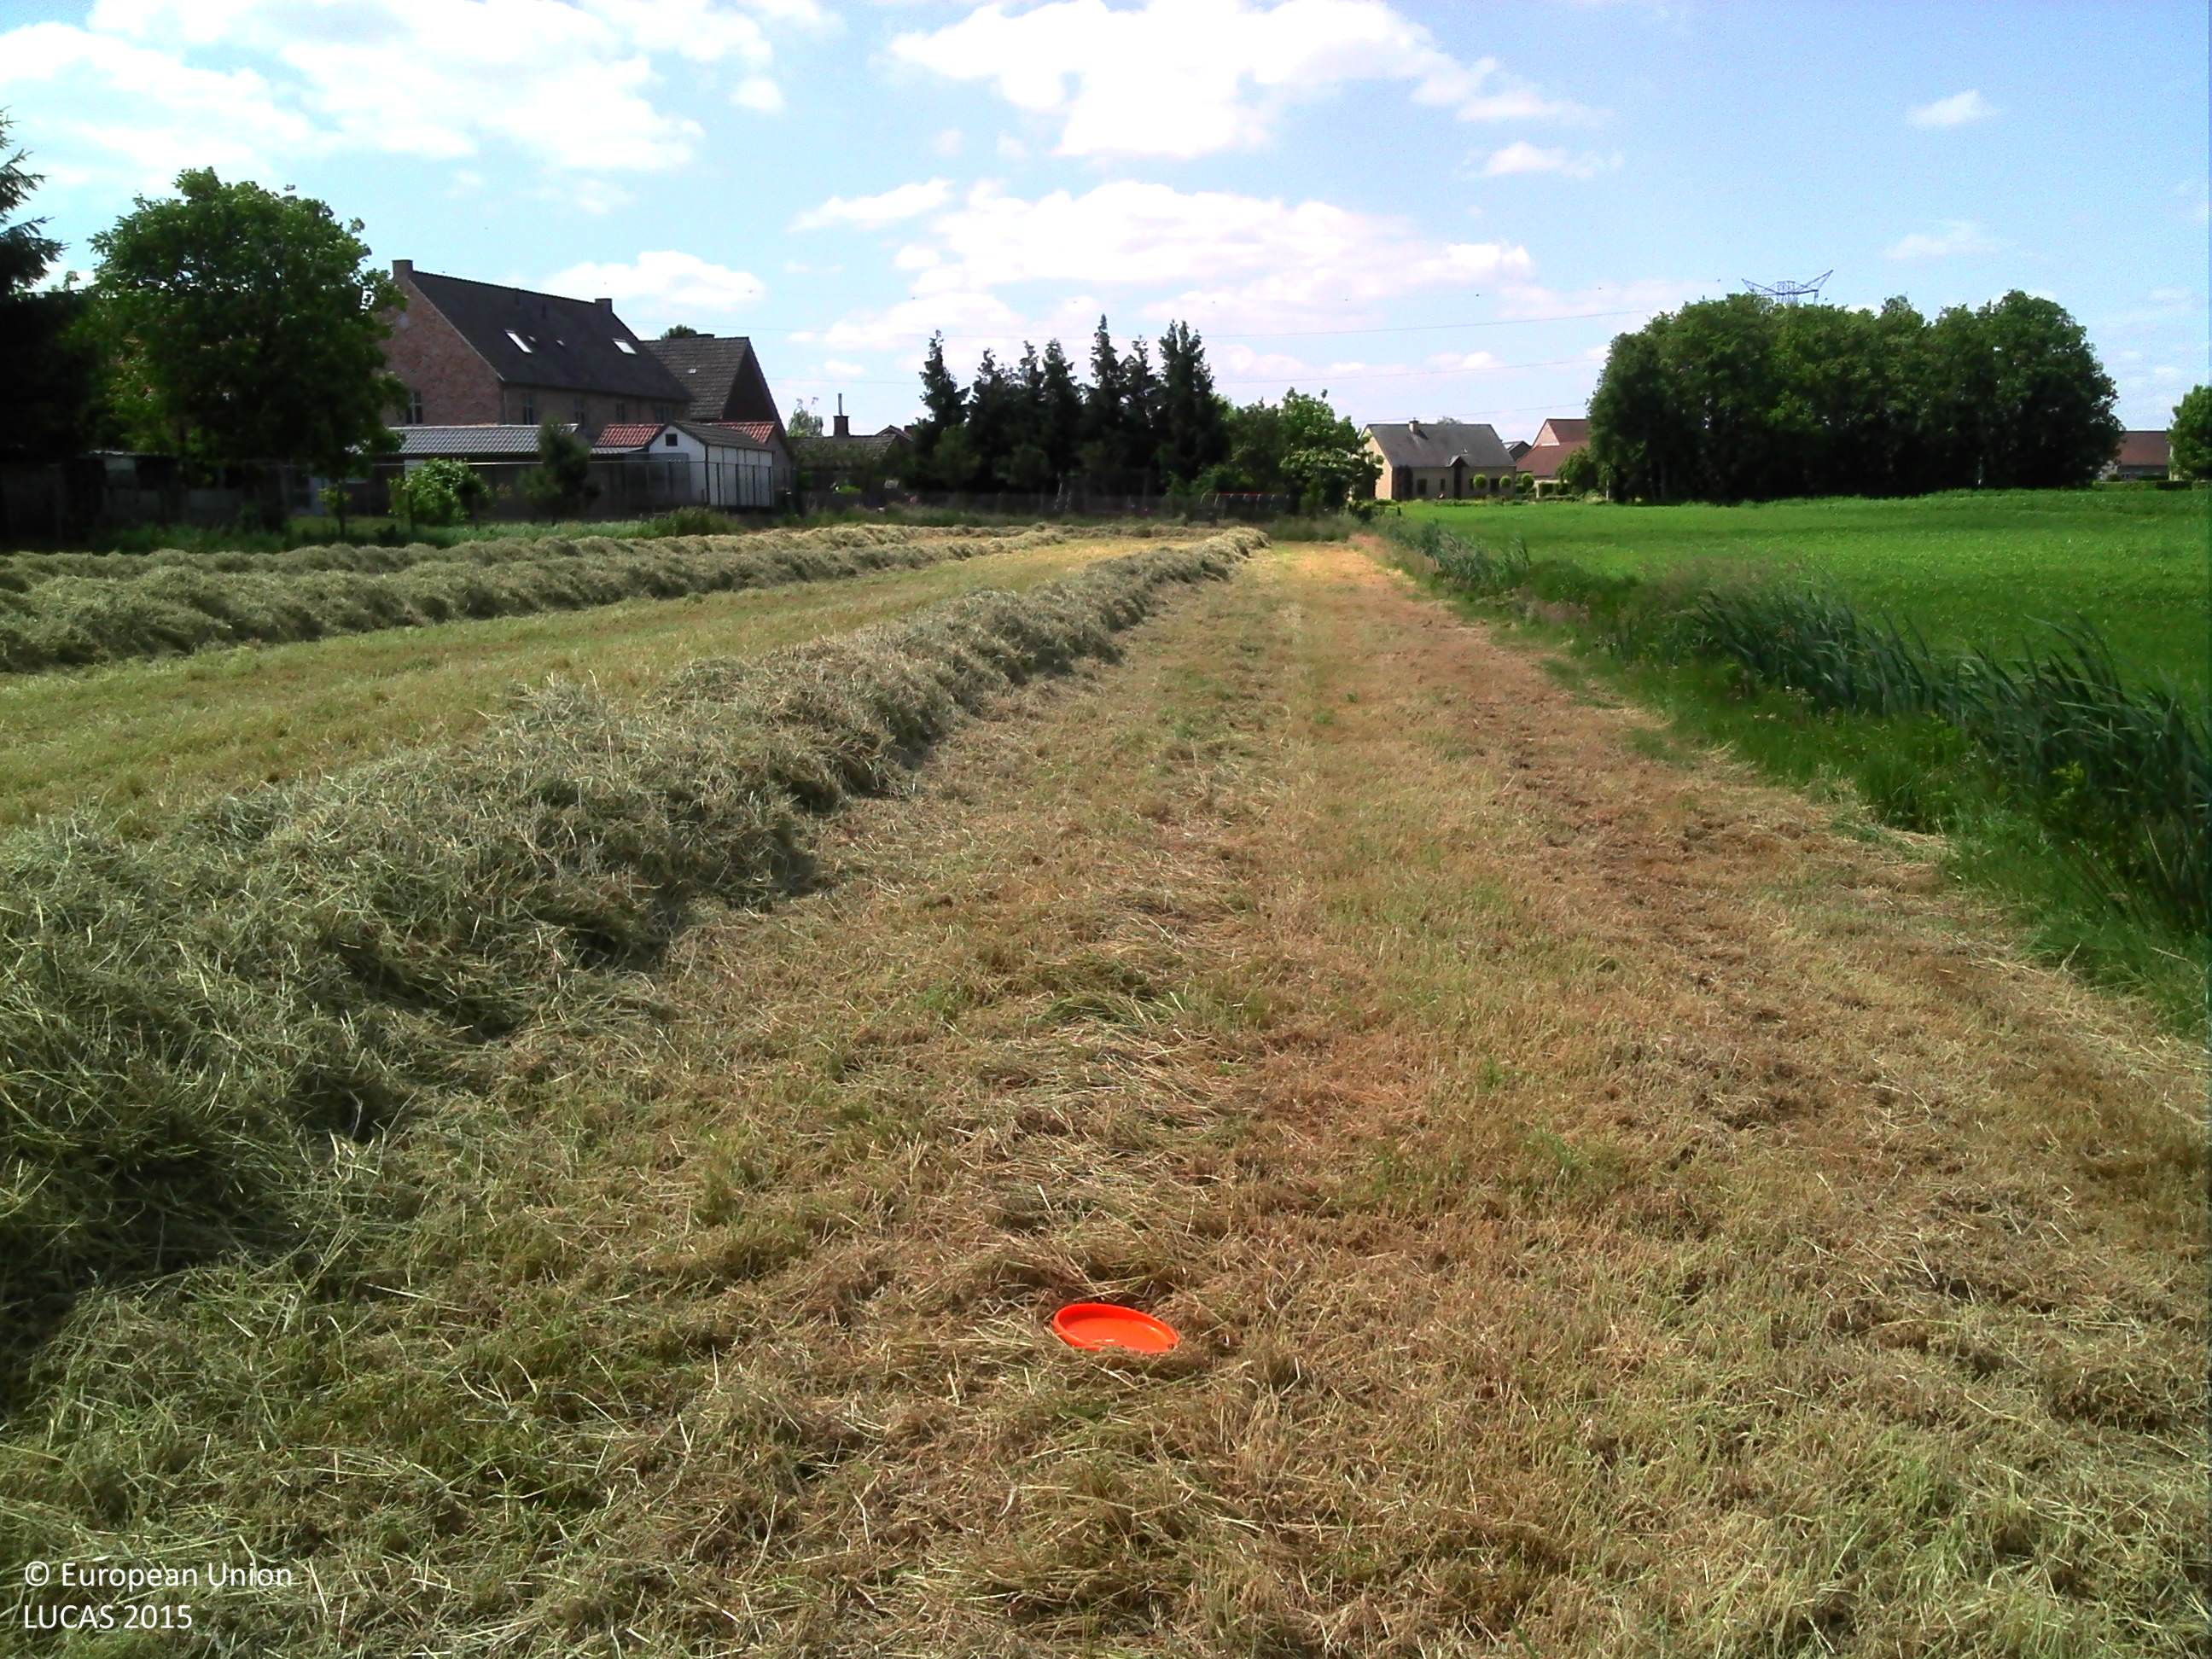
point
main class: Grassland
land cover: Grassland without tree/shrub cover
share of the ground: > 75 %
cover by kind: herbaceous plants 100 %
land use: Agriculture (excluding fallow land and kitchen gardens)
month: June
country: BE
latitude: 51.1484
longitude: 5.7242
